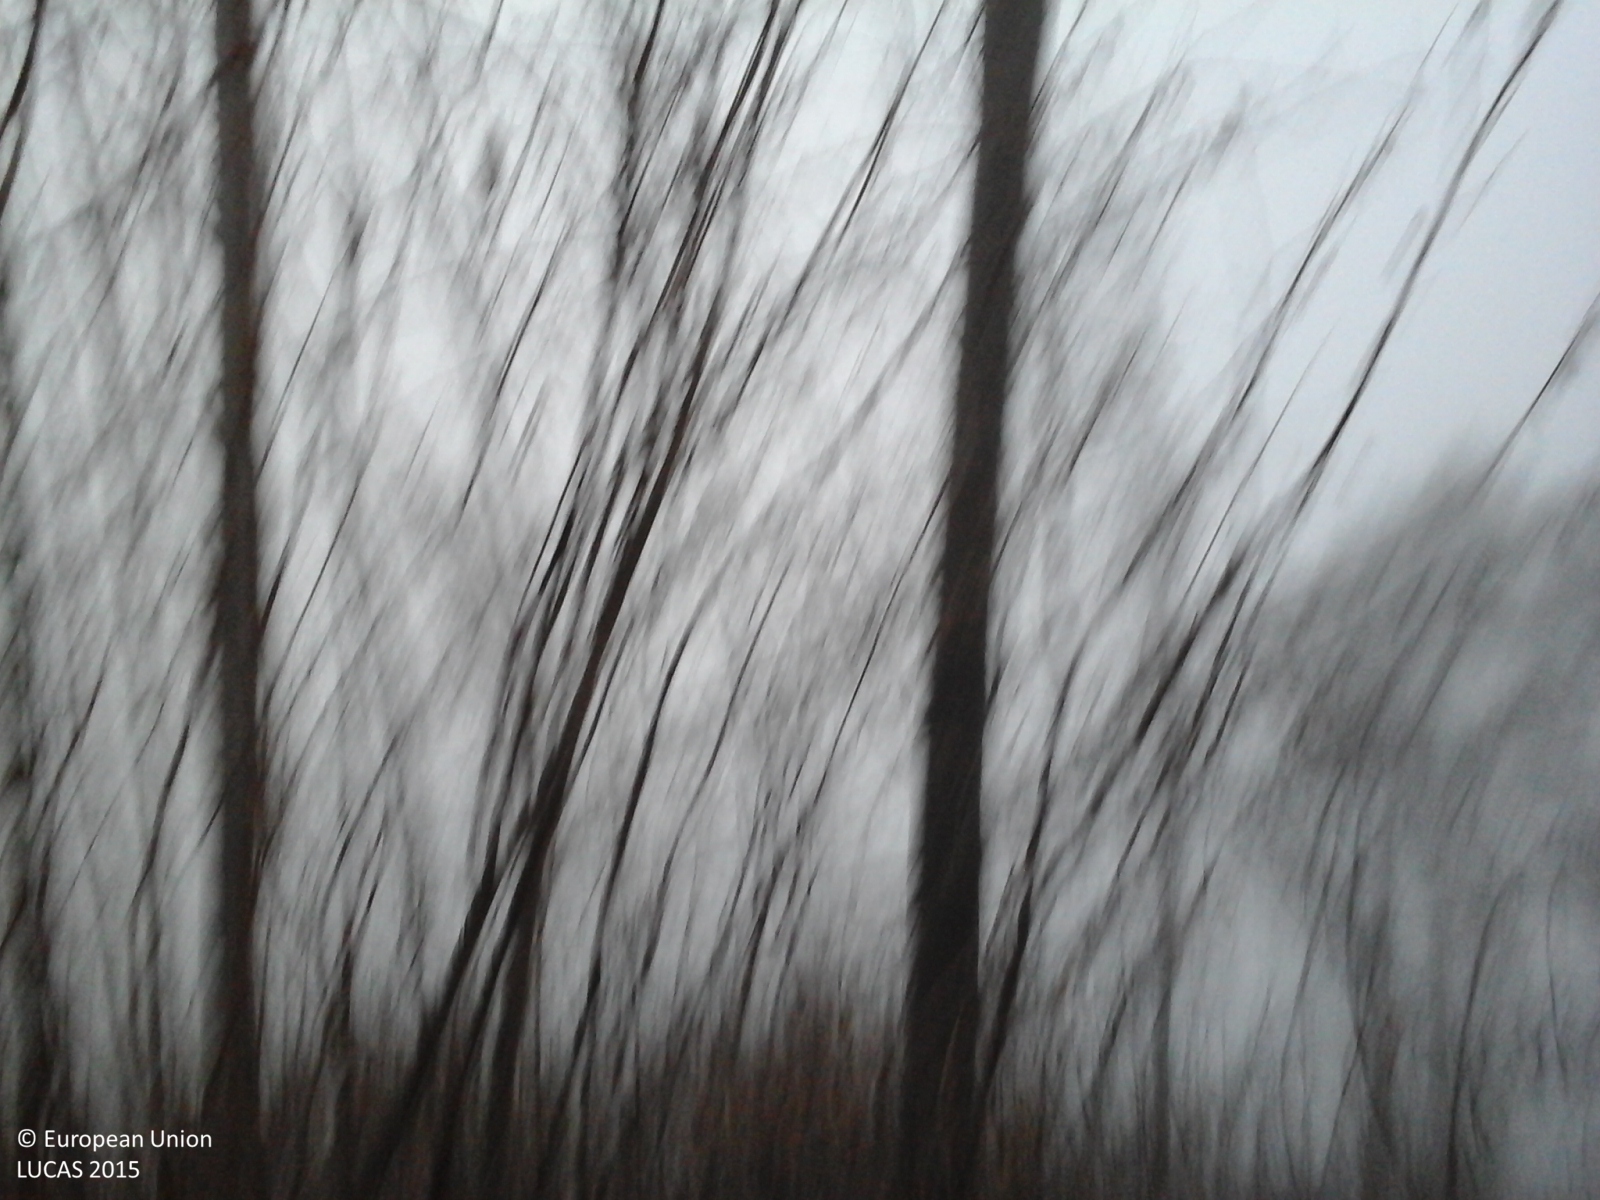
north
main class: Woodland
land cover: Broadleaved woodland
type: thermophilous deciduous forest
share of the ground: > 75 %
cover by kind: broadleaved forest trees 80 %, coniferous forest trees 20 %
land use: Forestry
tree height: > 5 m
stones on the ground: 10 - 25 %
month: January
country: IT
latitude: 44.0931
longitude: 7.8192
